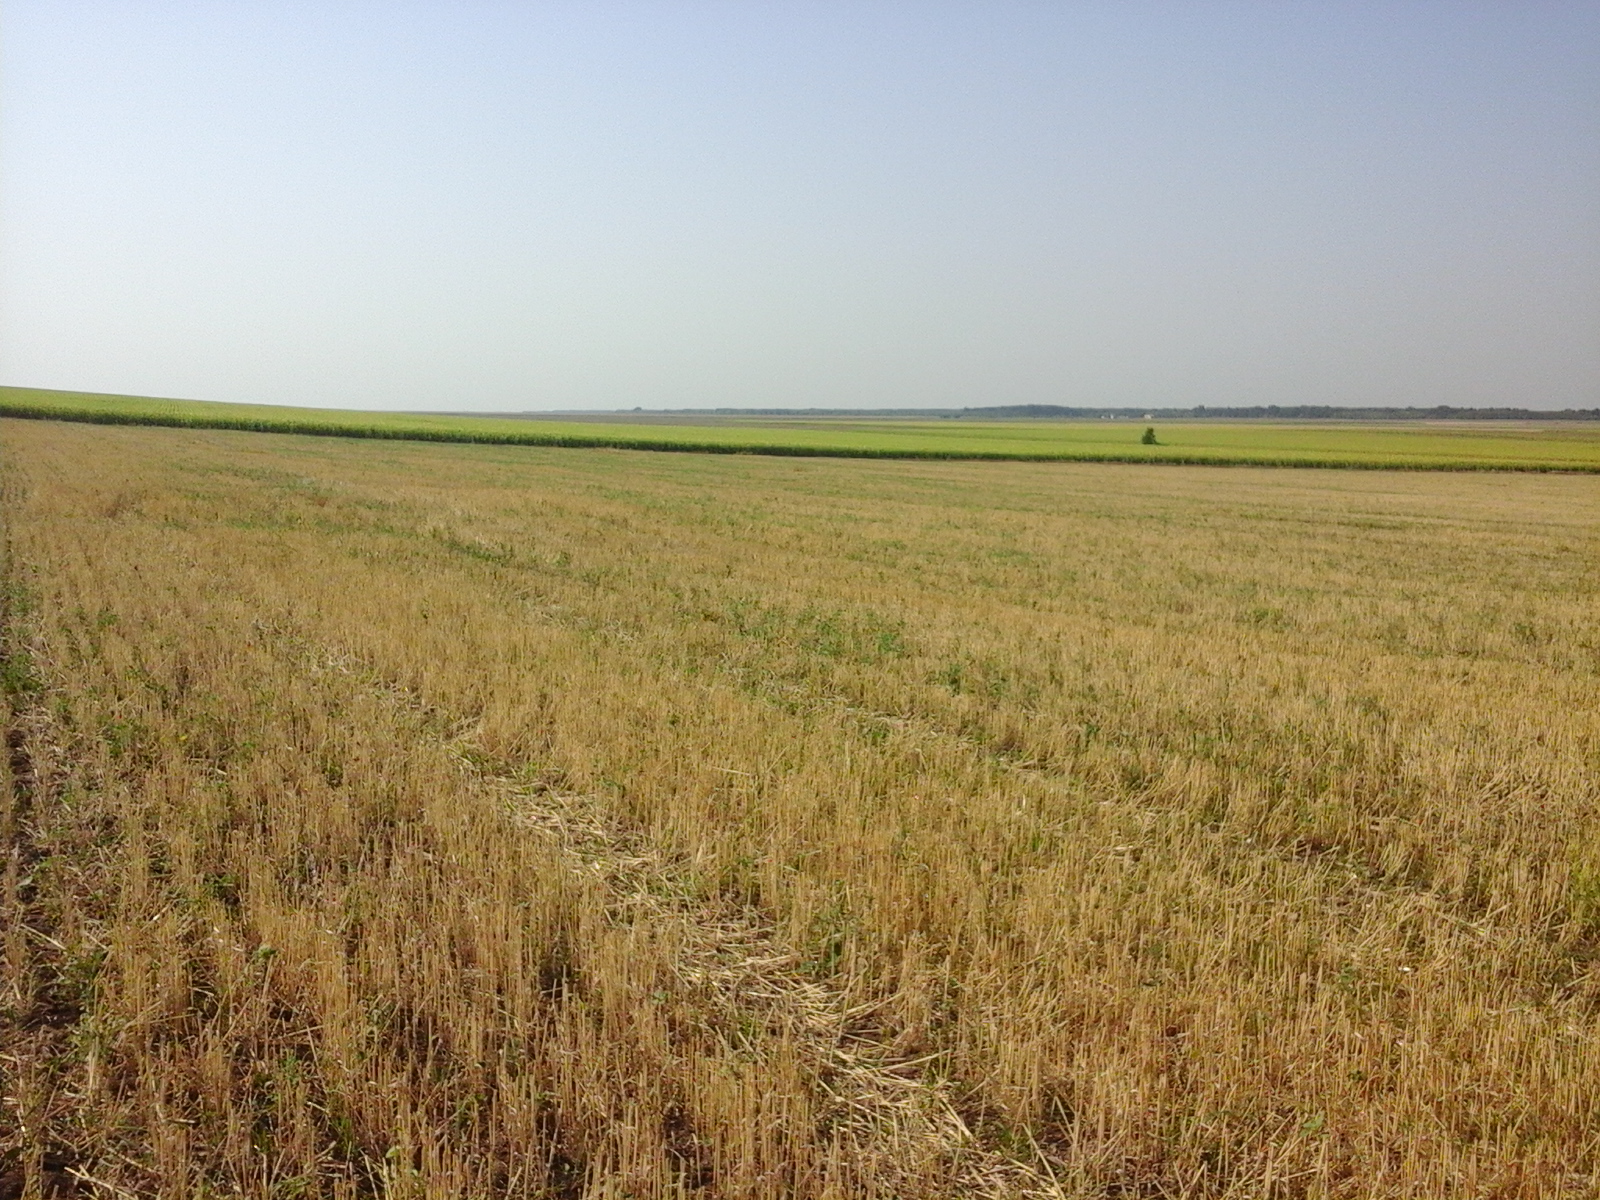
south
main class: Cropland
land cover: Common wheat
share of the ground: > 75 %
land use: Agriculture (excluding fallow land and kitchen gardens)
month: August
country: RO
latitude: 45.8076
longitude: 27.5423
